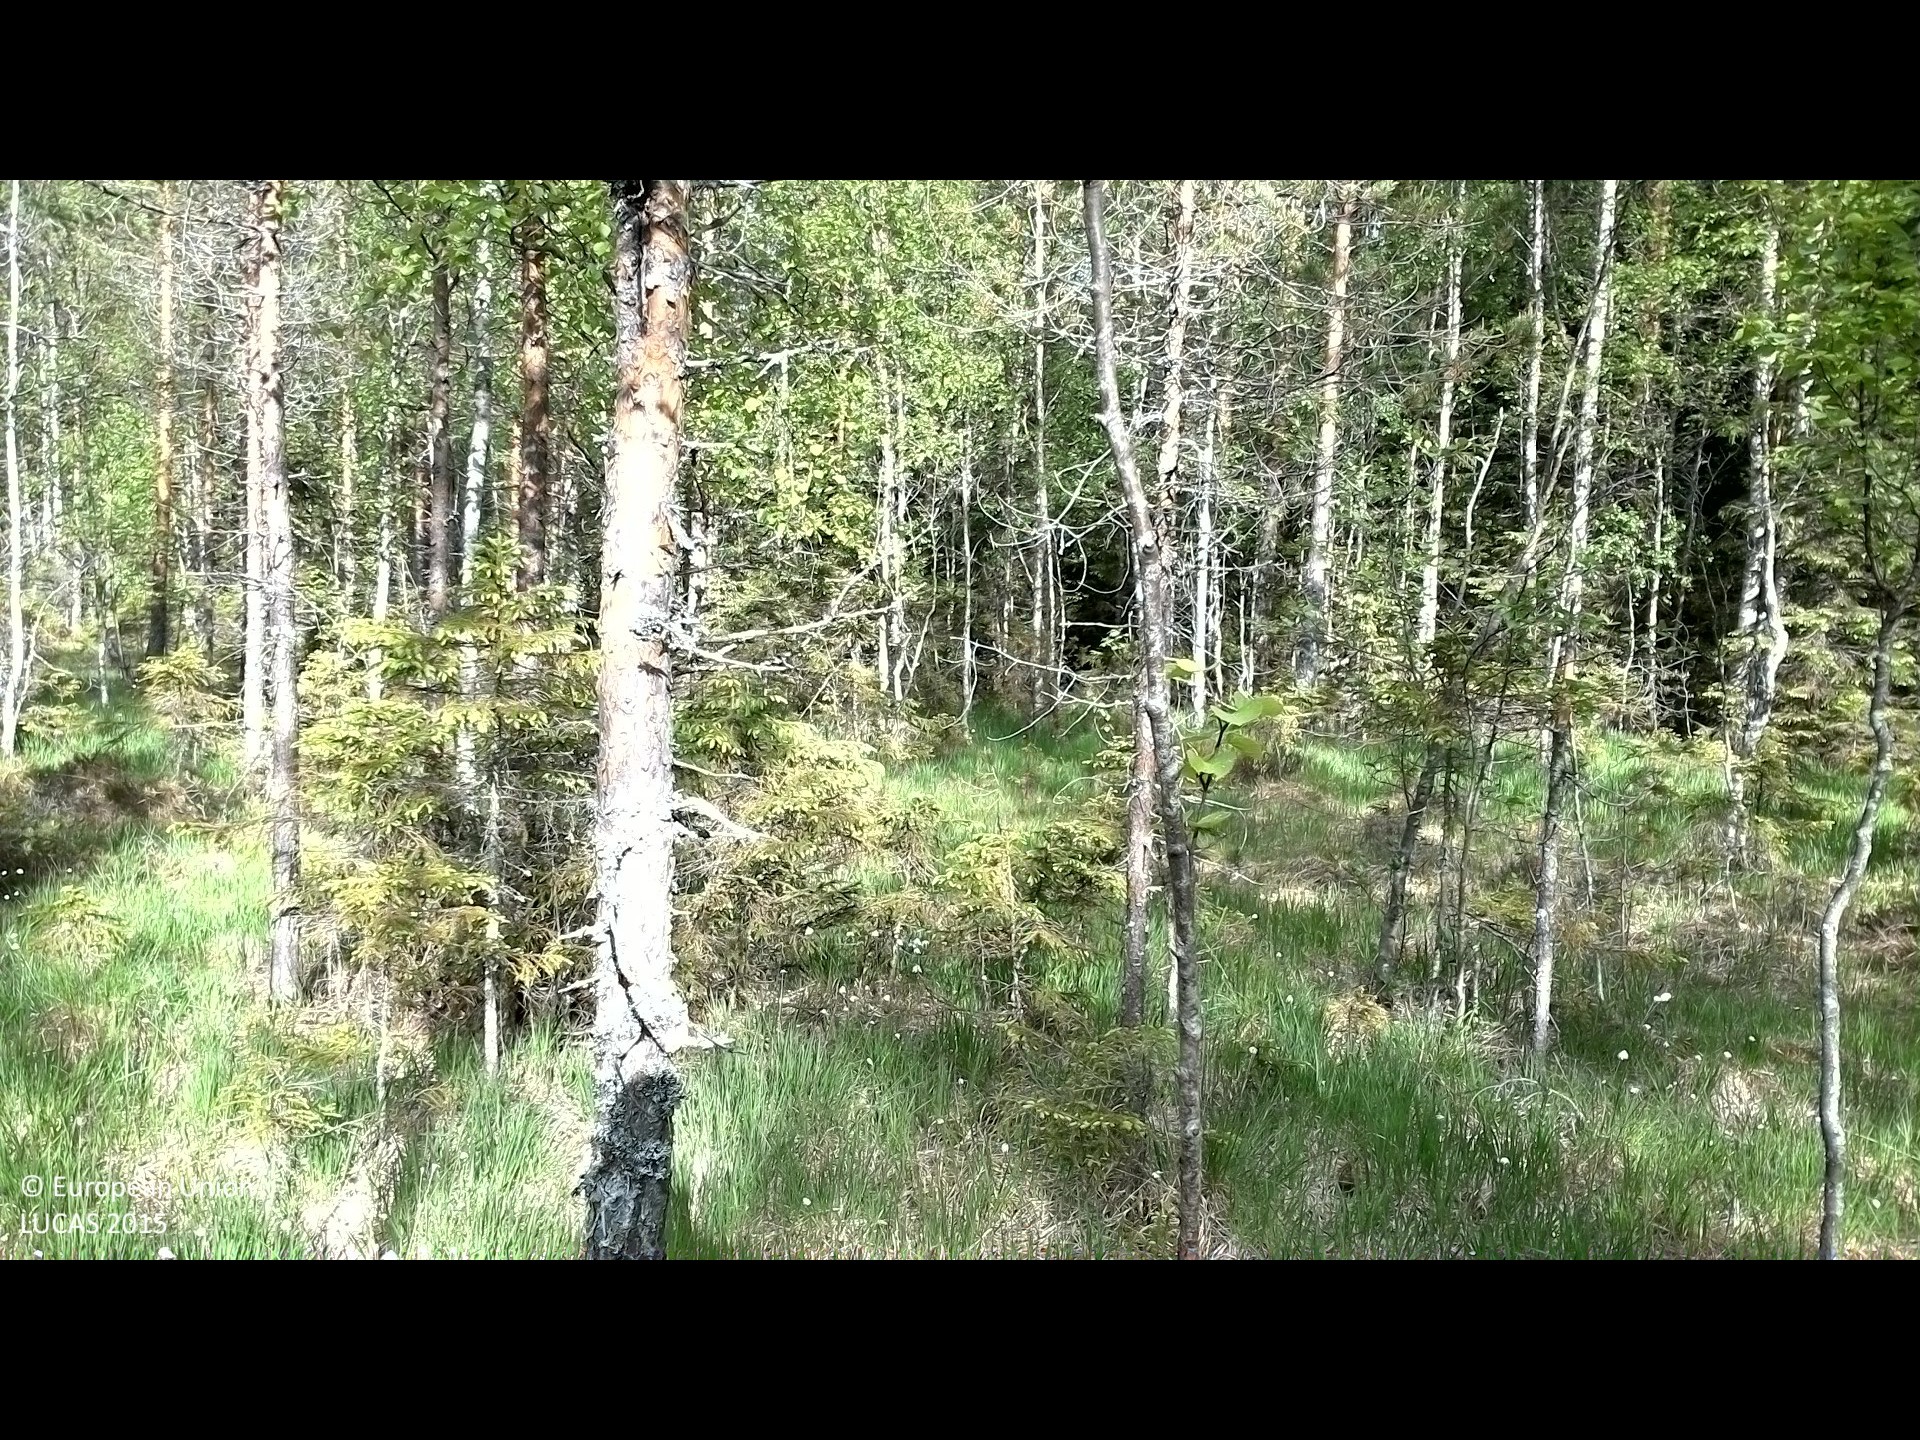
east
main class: Woodland
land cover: Pine dominated mixed woodland
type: boreal forest
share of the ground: 10 - 25 %
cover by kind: herbaceous plants 40 %, lichens and mosses 30 %, coniferous forest trees 15 %, broadleaved forest trees 10 %, shrubs 5 %
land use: Semi-natural and natural areas not in use
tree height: > 5 m
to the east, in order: Pine dominated mixed woodland; Ditches and canals; Pine dominated mixed woodland; Ditches and canals; Pine dominated mixed woodland; Tracks; Pine dominated coniferous woodland; Tracks; Pine dominated coniferous woodland
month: June
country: SE
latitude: 62.0079
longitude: 16.7619
